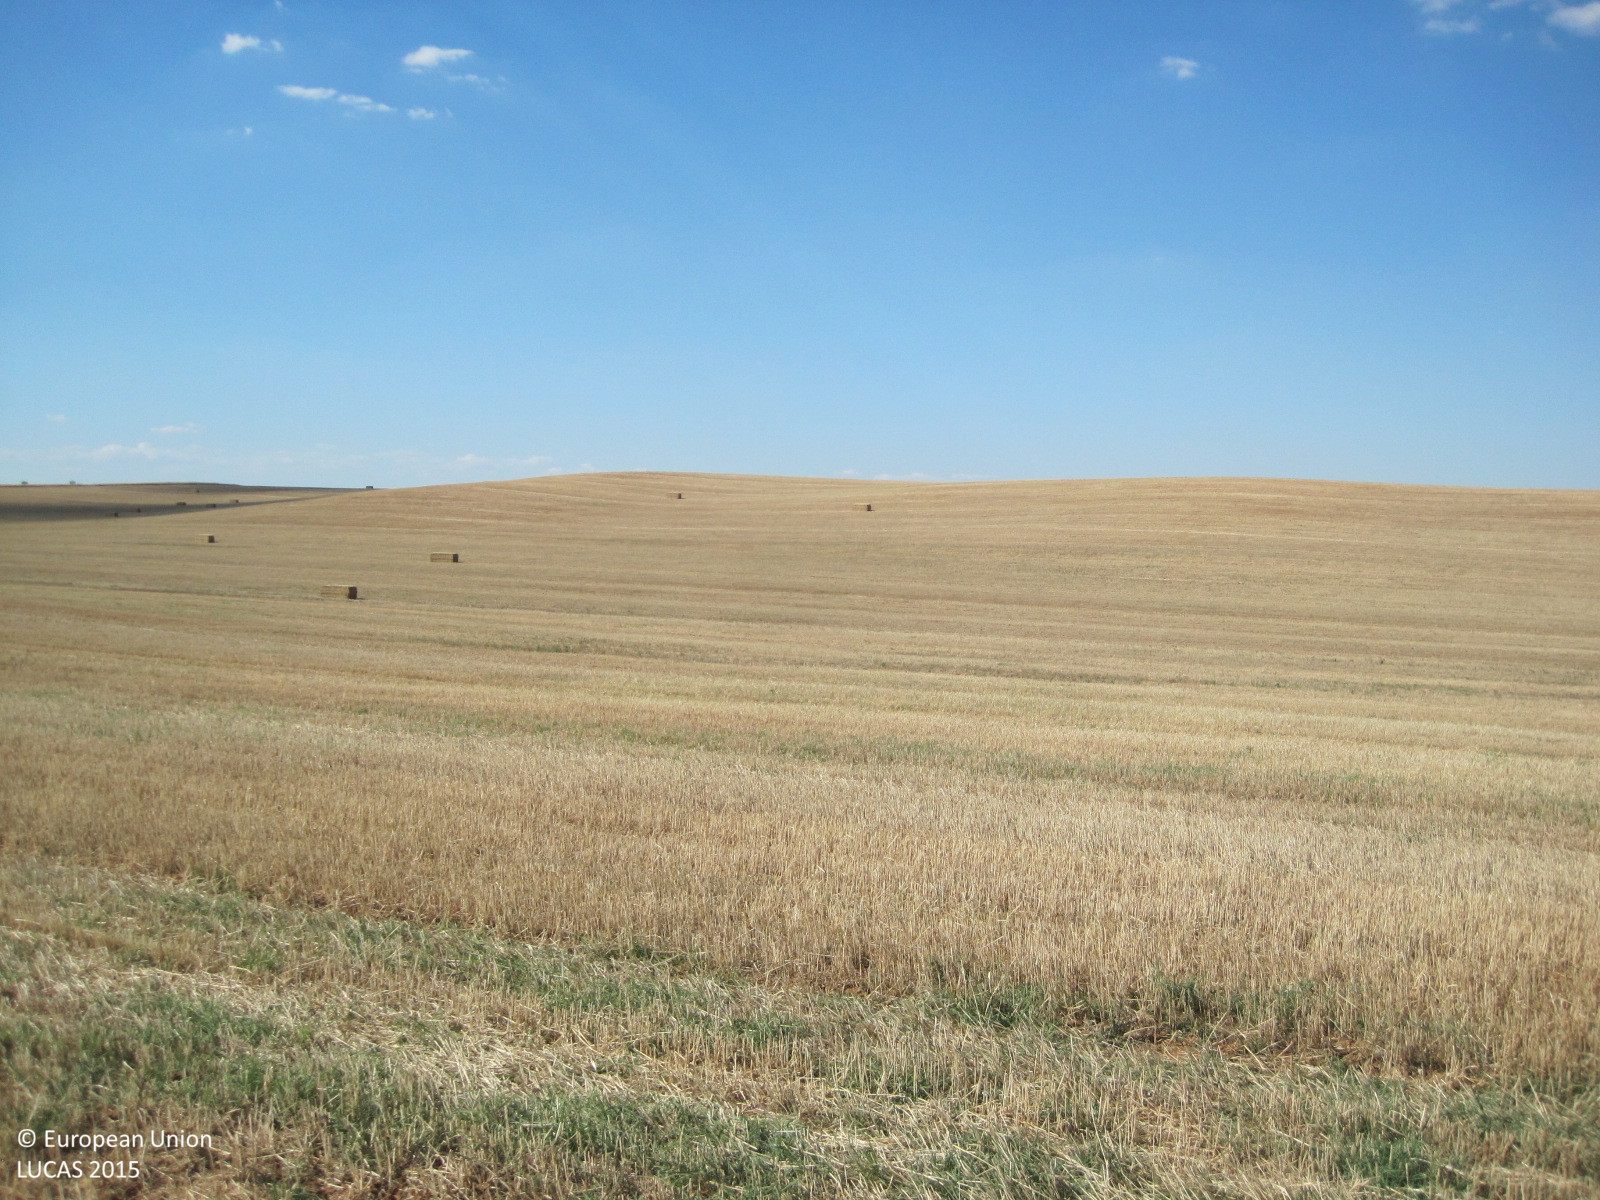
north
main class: Cropland
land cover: Barley
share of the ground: < 10 %
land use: Agriculture (excluding fallow land and kitchen gardens)
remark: Harvested field
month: June
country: ES
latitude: 39.9245
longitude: -4.2070
